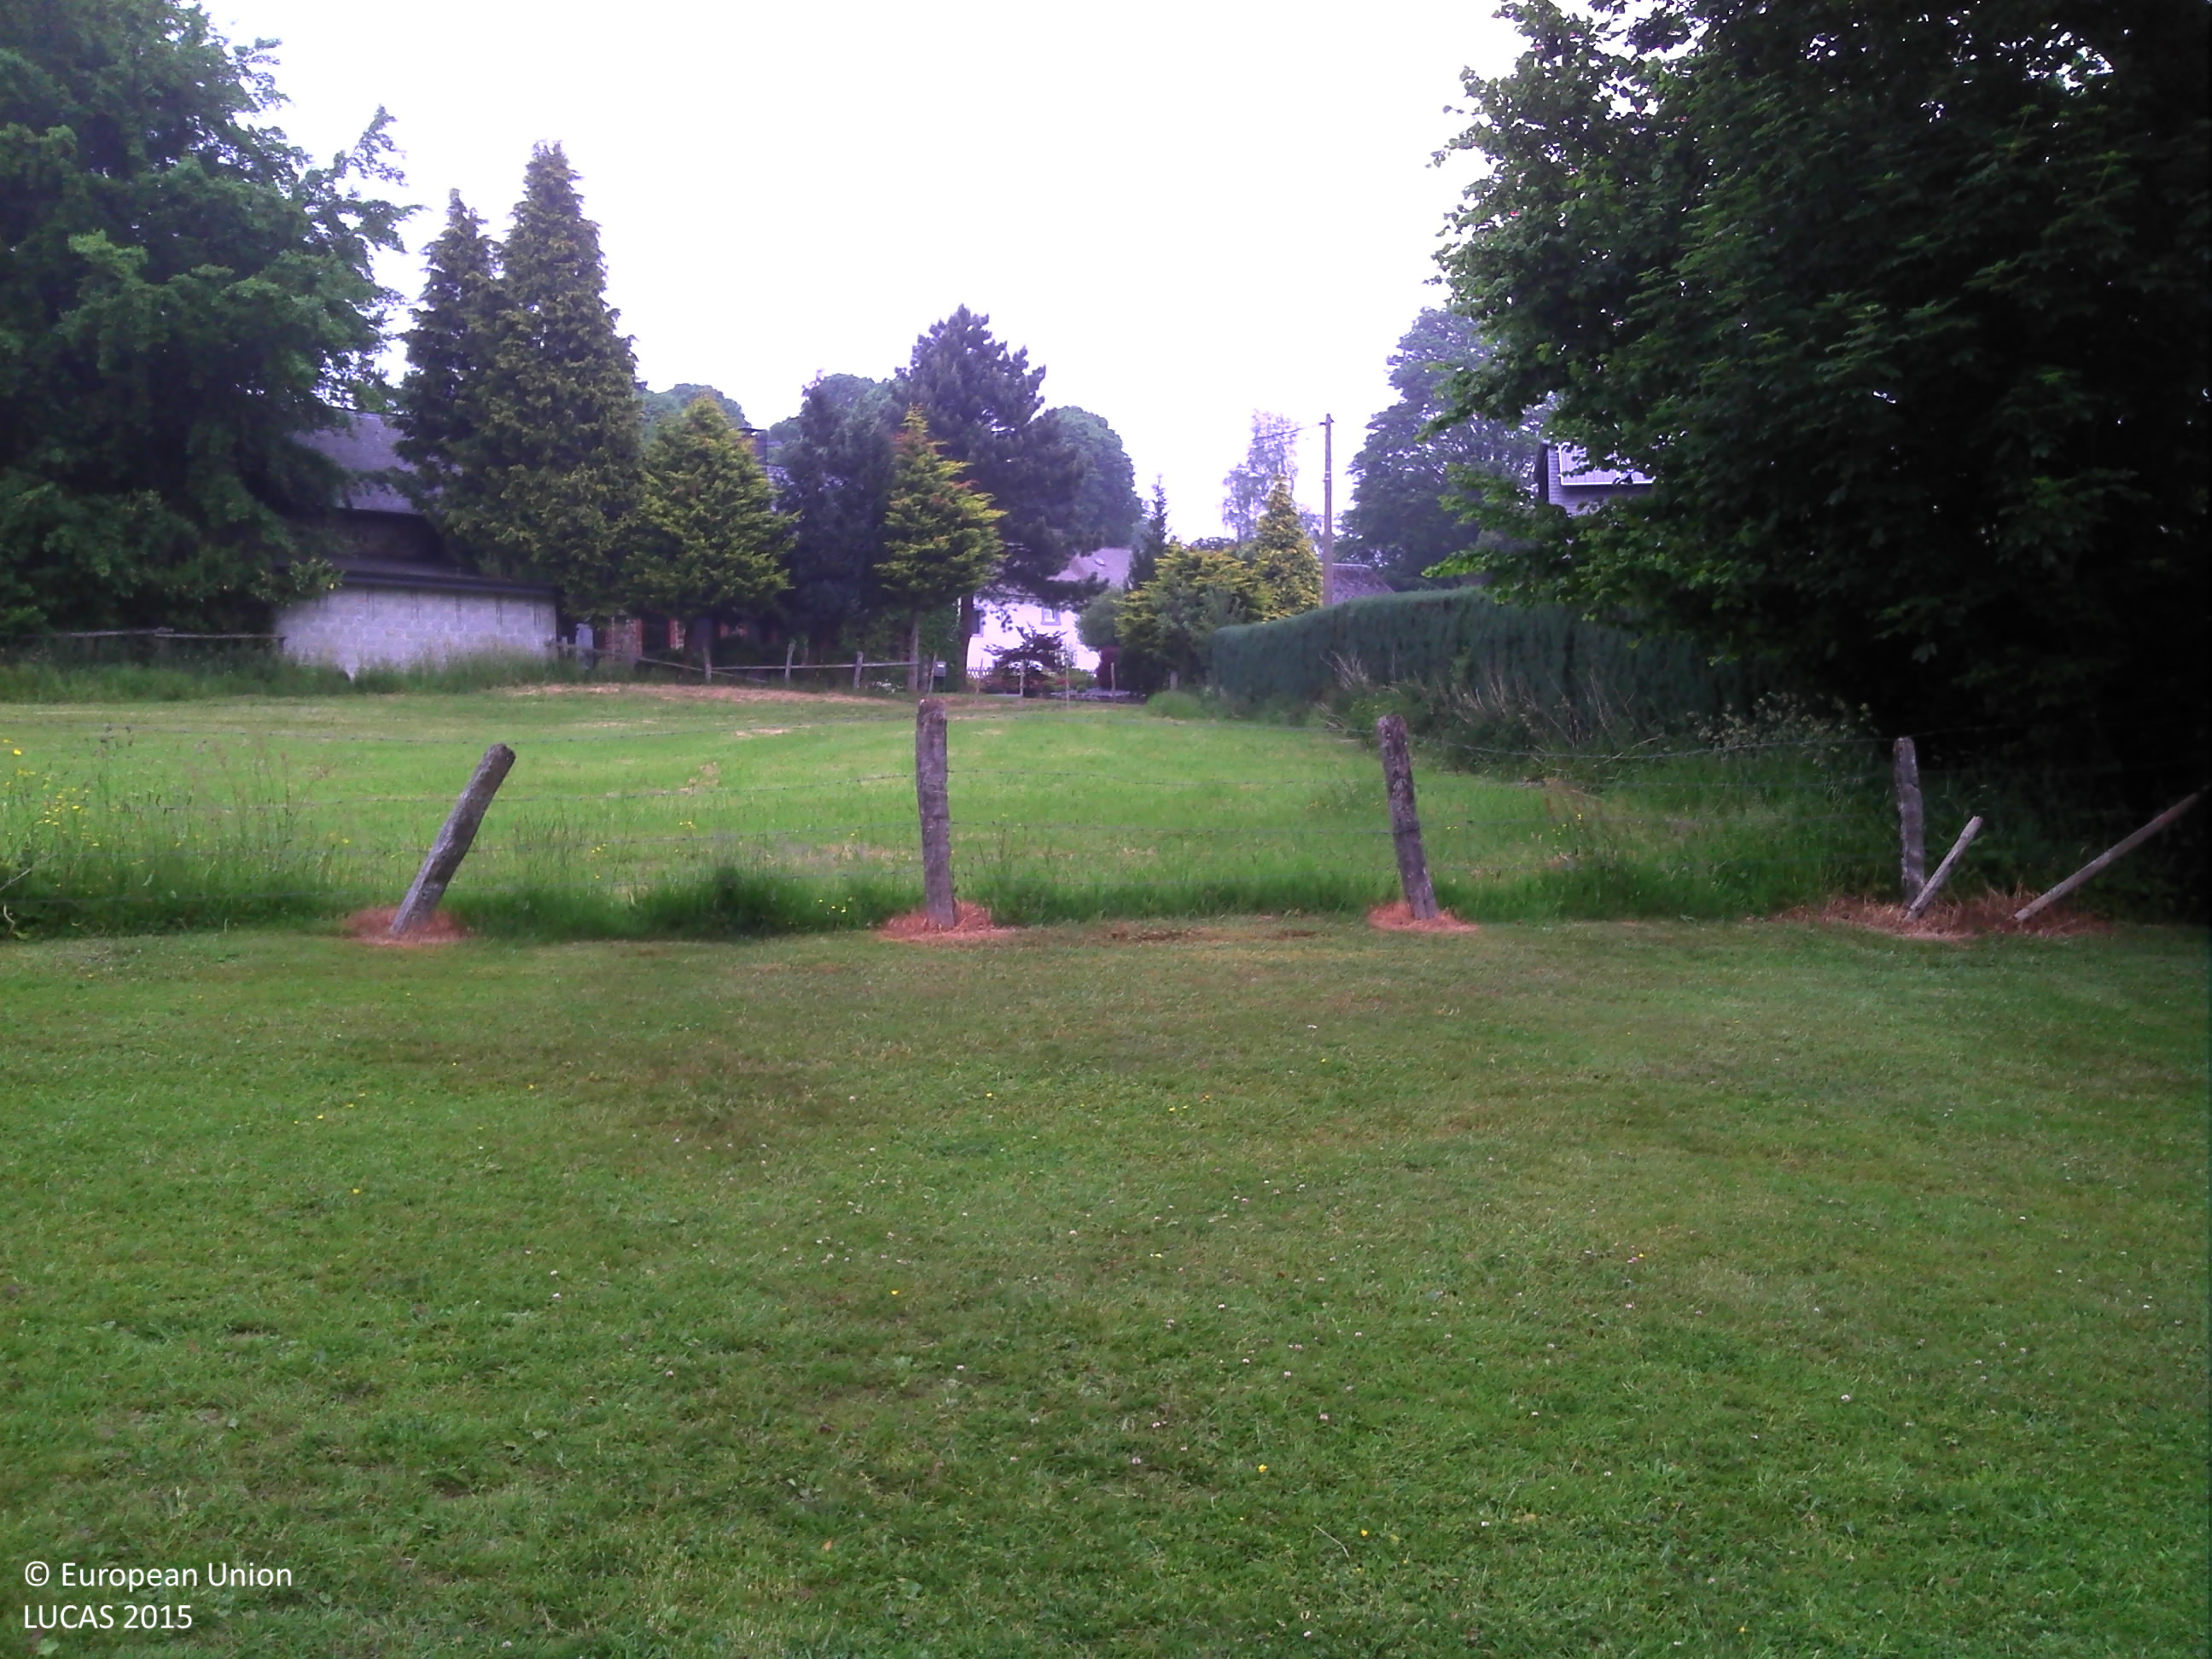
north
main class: Grassland
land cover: Grassland without tree/shrub cover
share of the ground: > 75 %
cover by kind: herbaceous plants 100 %
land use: Residential
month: June
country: BE
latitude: 50.4301
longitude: 6.2970
